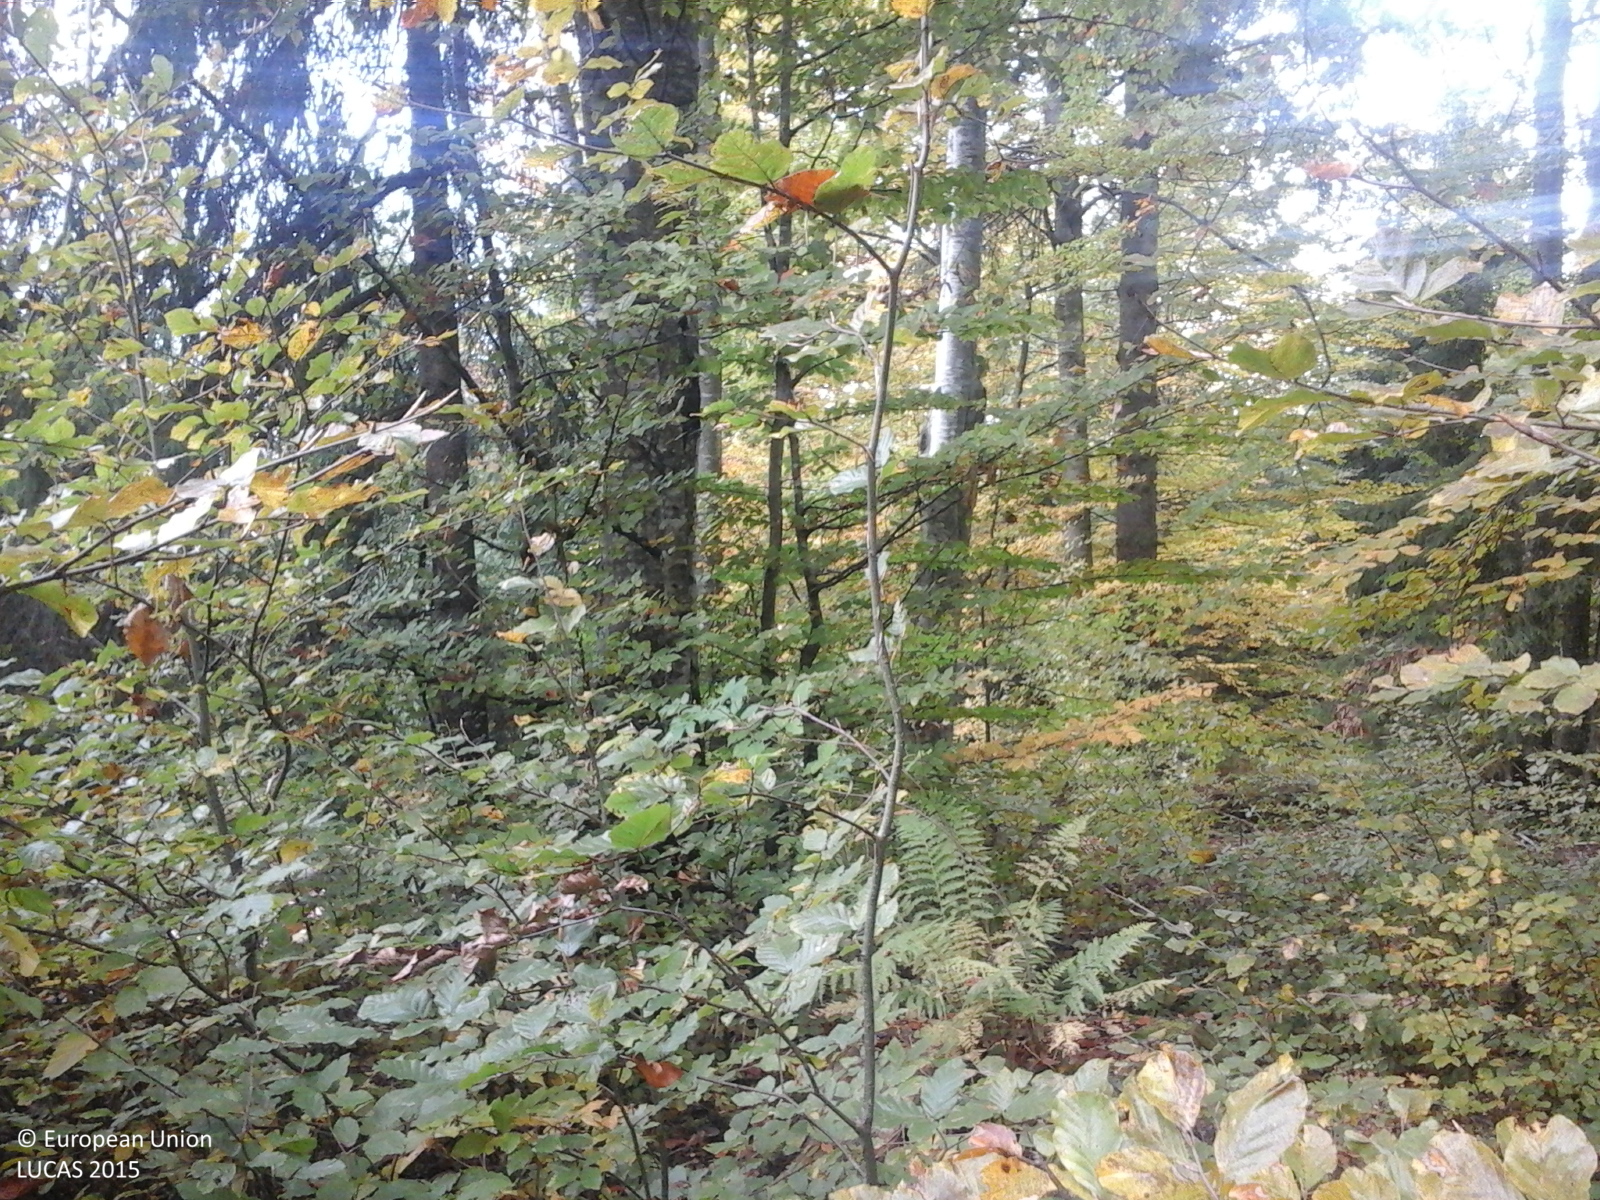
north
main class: Woodland
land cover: Other mixed woodland
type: alpine coniferous forest
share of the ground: > 75 %
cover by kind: coniferous forest trees 60 %, broadleaved forest trees 40 %
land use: Forestry
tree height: > 5 m
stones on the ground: 10 - 25 %
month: October
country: RO
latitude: 46.5507
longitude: 25.2455
